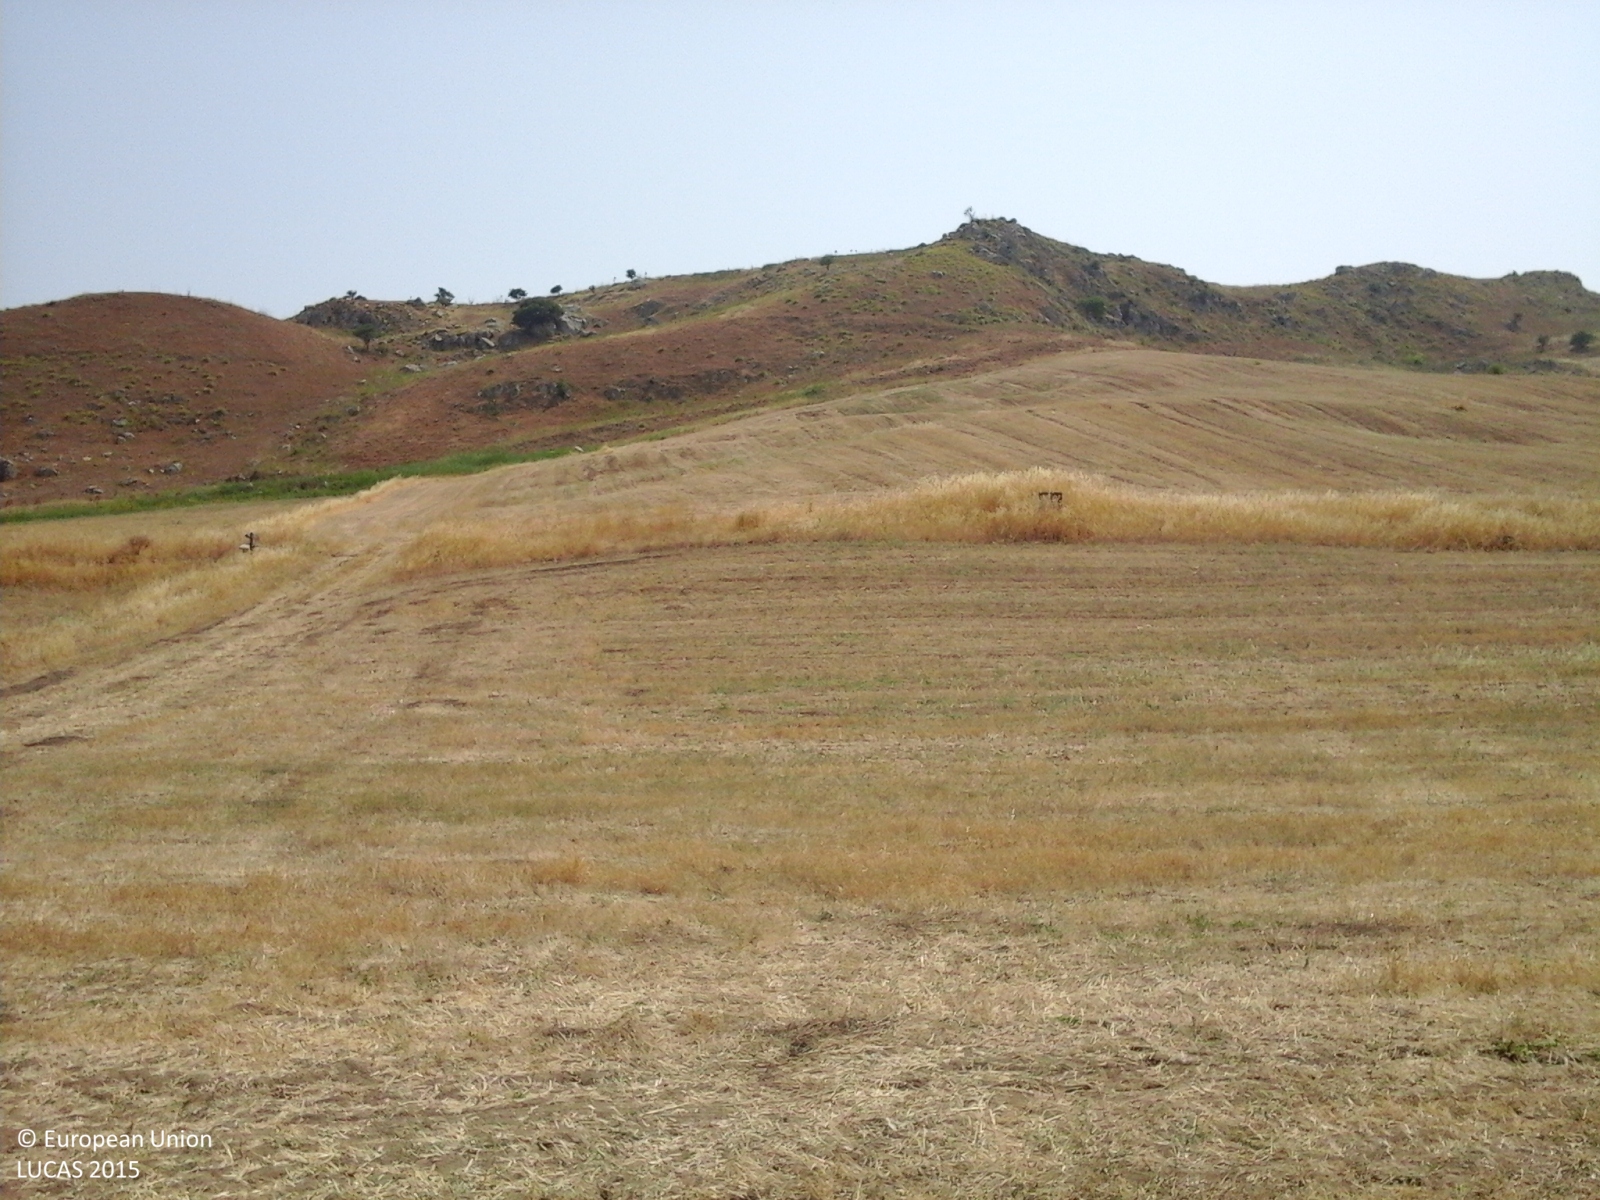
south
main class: Grassland
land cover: Grassland without tree/shrub cover
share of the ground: > 75 %
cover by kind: herbaceous plants 100 %
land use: Agriculture (excluding fallow land and kitchen gardens)
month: July
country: IT
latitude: 37.2809
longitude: 14.0180
